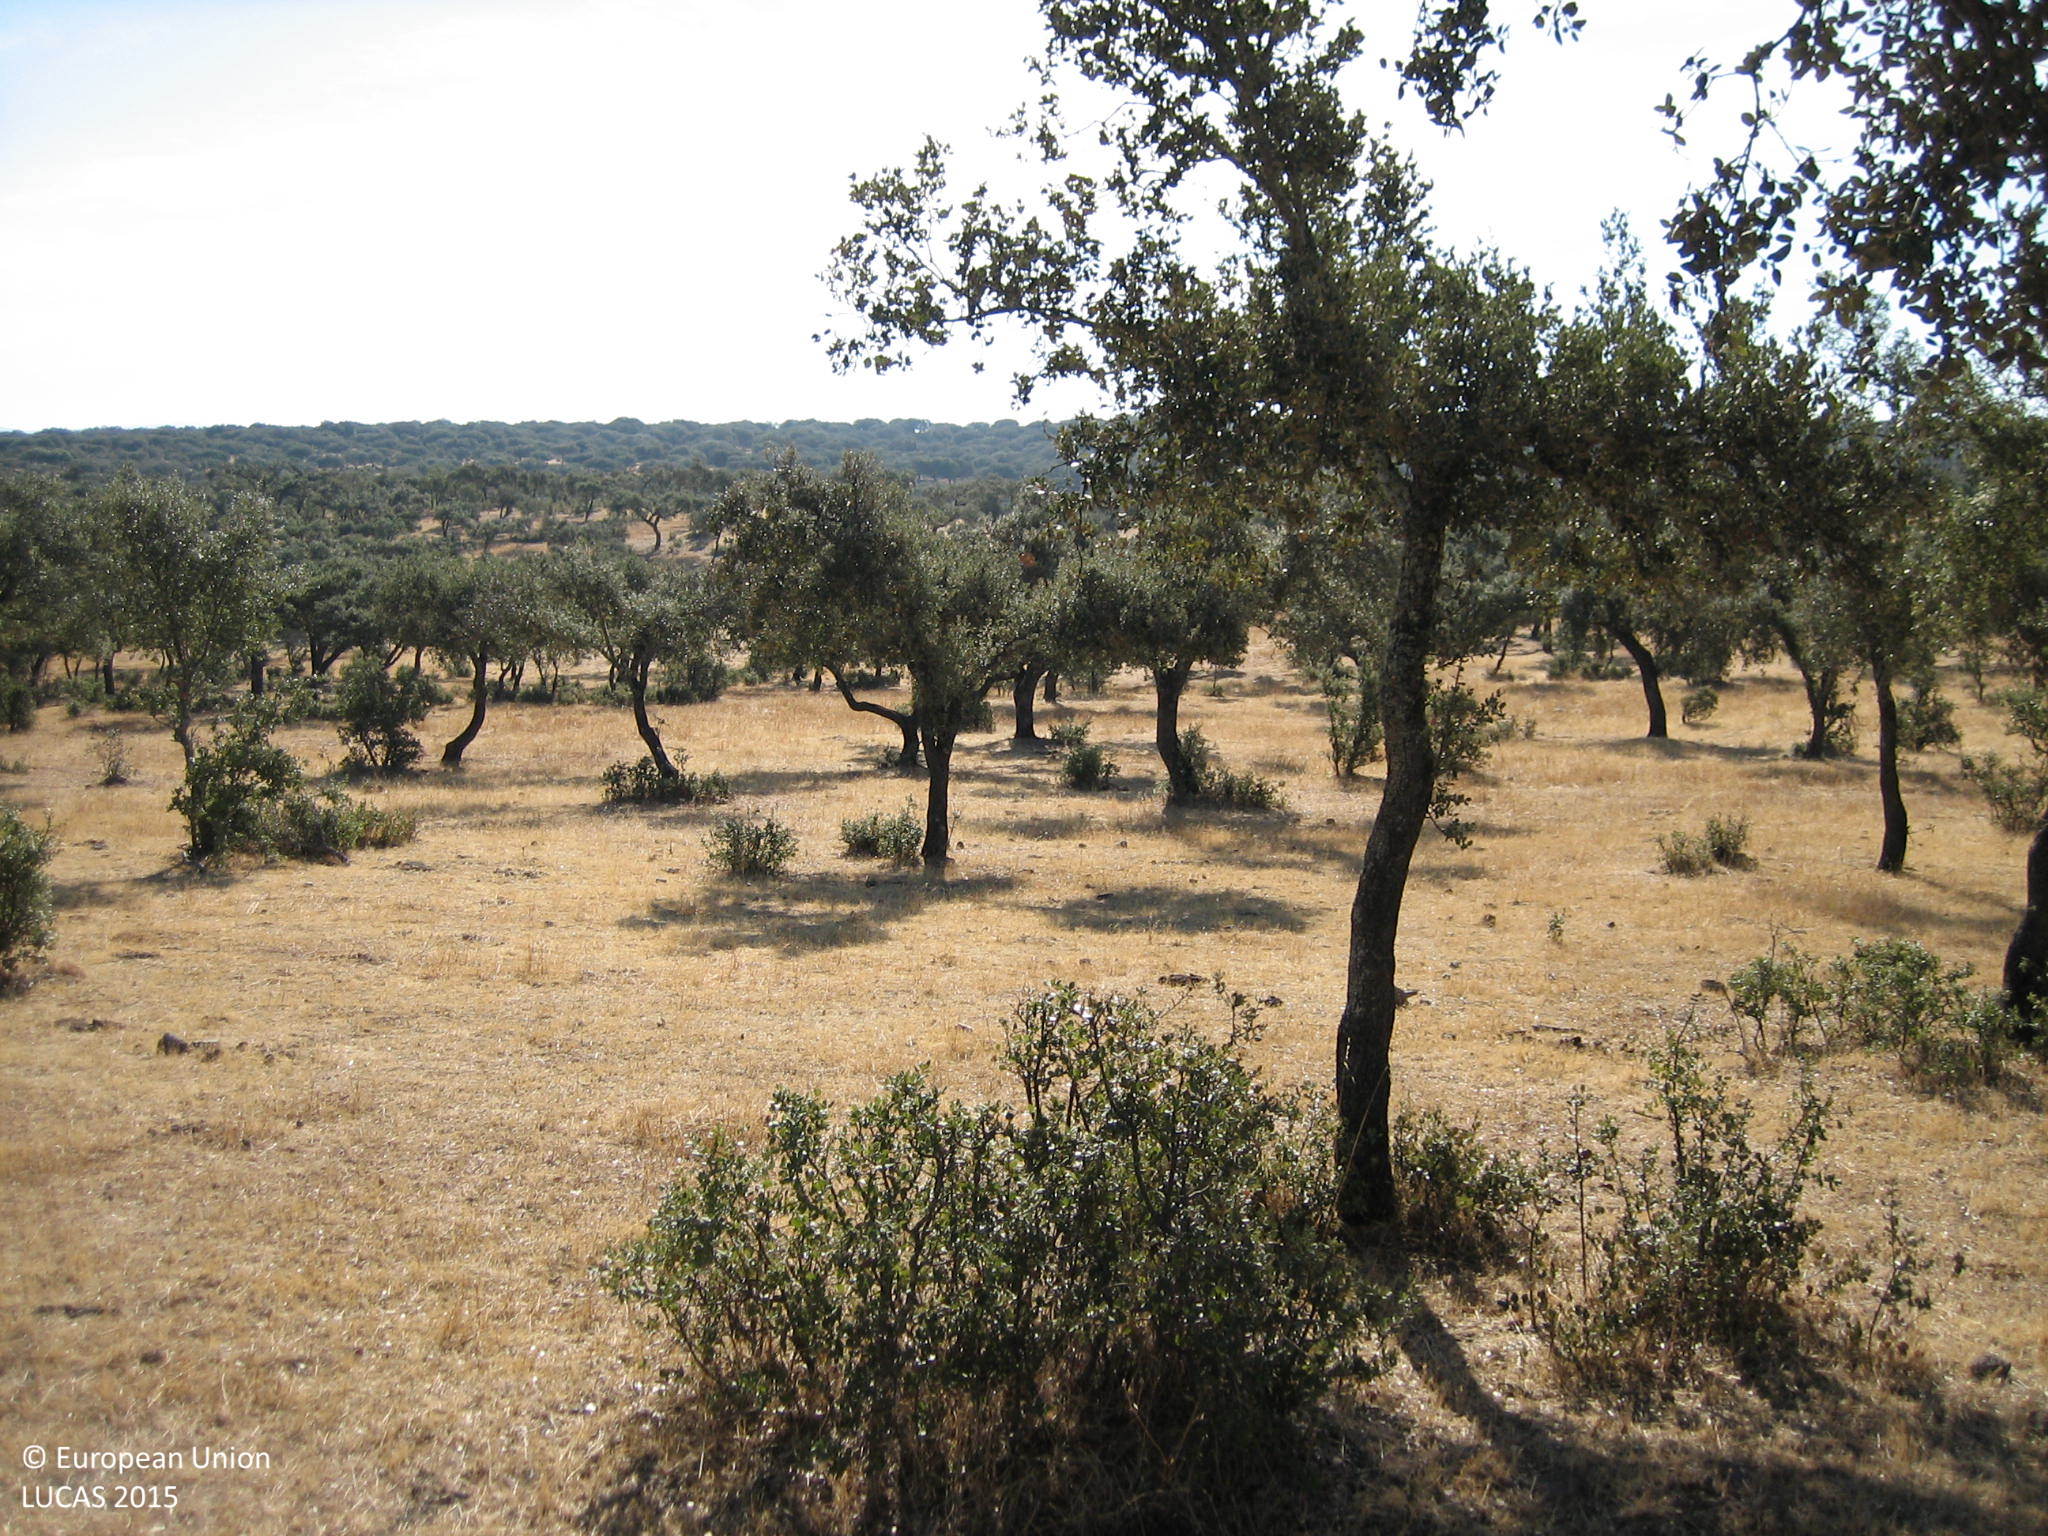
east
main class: Woodland
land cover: Broadleaved woodland
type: broadleaved evergreen forest
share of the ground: 10 - 25 %
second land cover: Grassland without tree/shrub cover
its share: > 75 %
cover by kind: herbaceous plants 80 %, broadleaved forest trees 10 %, unconsolidated bare surface 10 %
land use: Forestry
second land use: Agriculture (excluding fallow land and kitchen gardens)
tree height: < 5 m
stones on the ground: < 10 %
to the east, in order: Broadleaved woodland; Grassland without tree/shrub cover
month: August
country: ES
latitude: 38.5427
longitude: -7.2449
